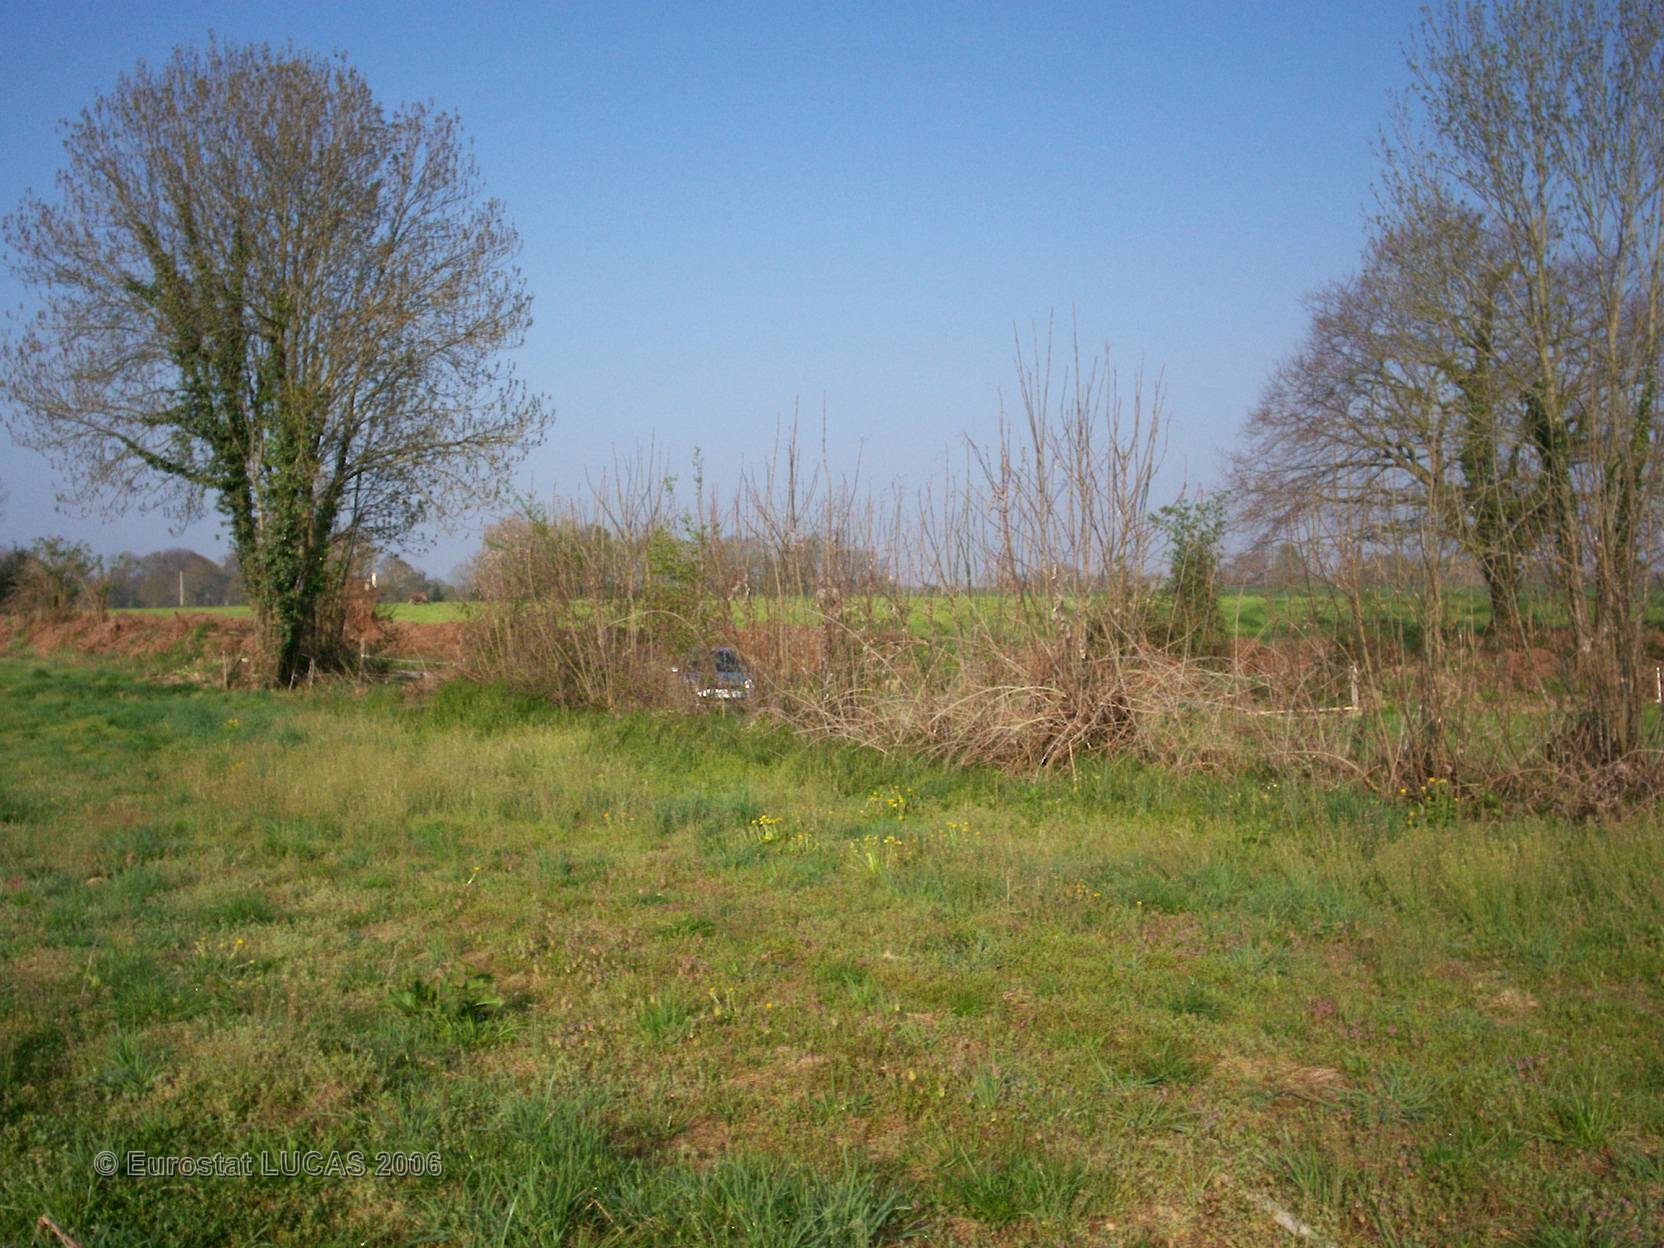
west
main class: Grassland
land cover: Grassland without tree/shrub cover
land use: Fallow land
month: April
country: FR
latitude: 43.2885
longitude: -0.1481
